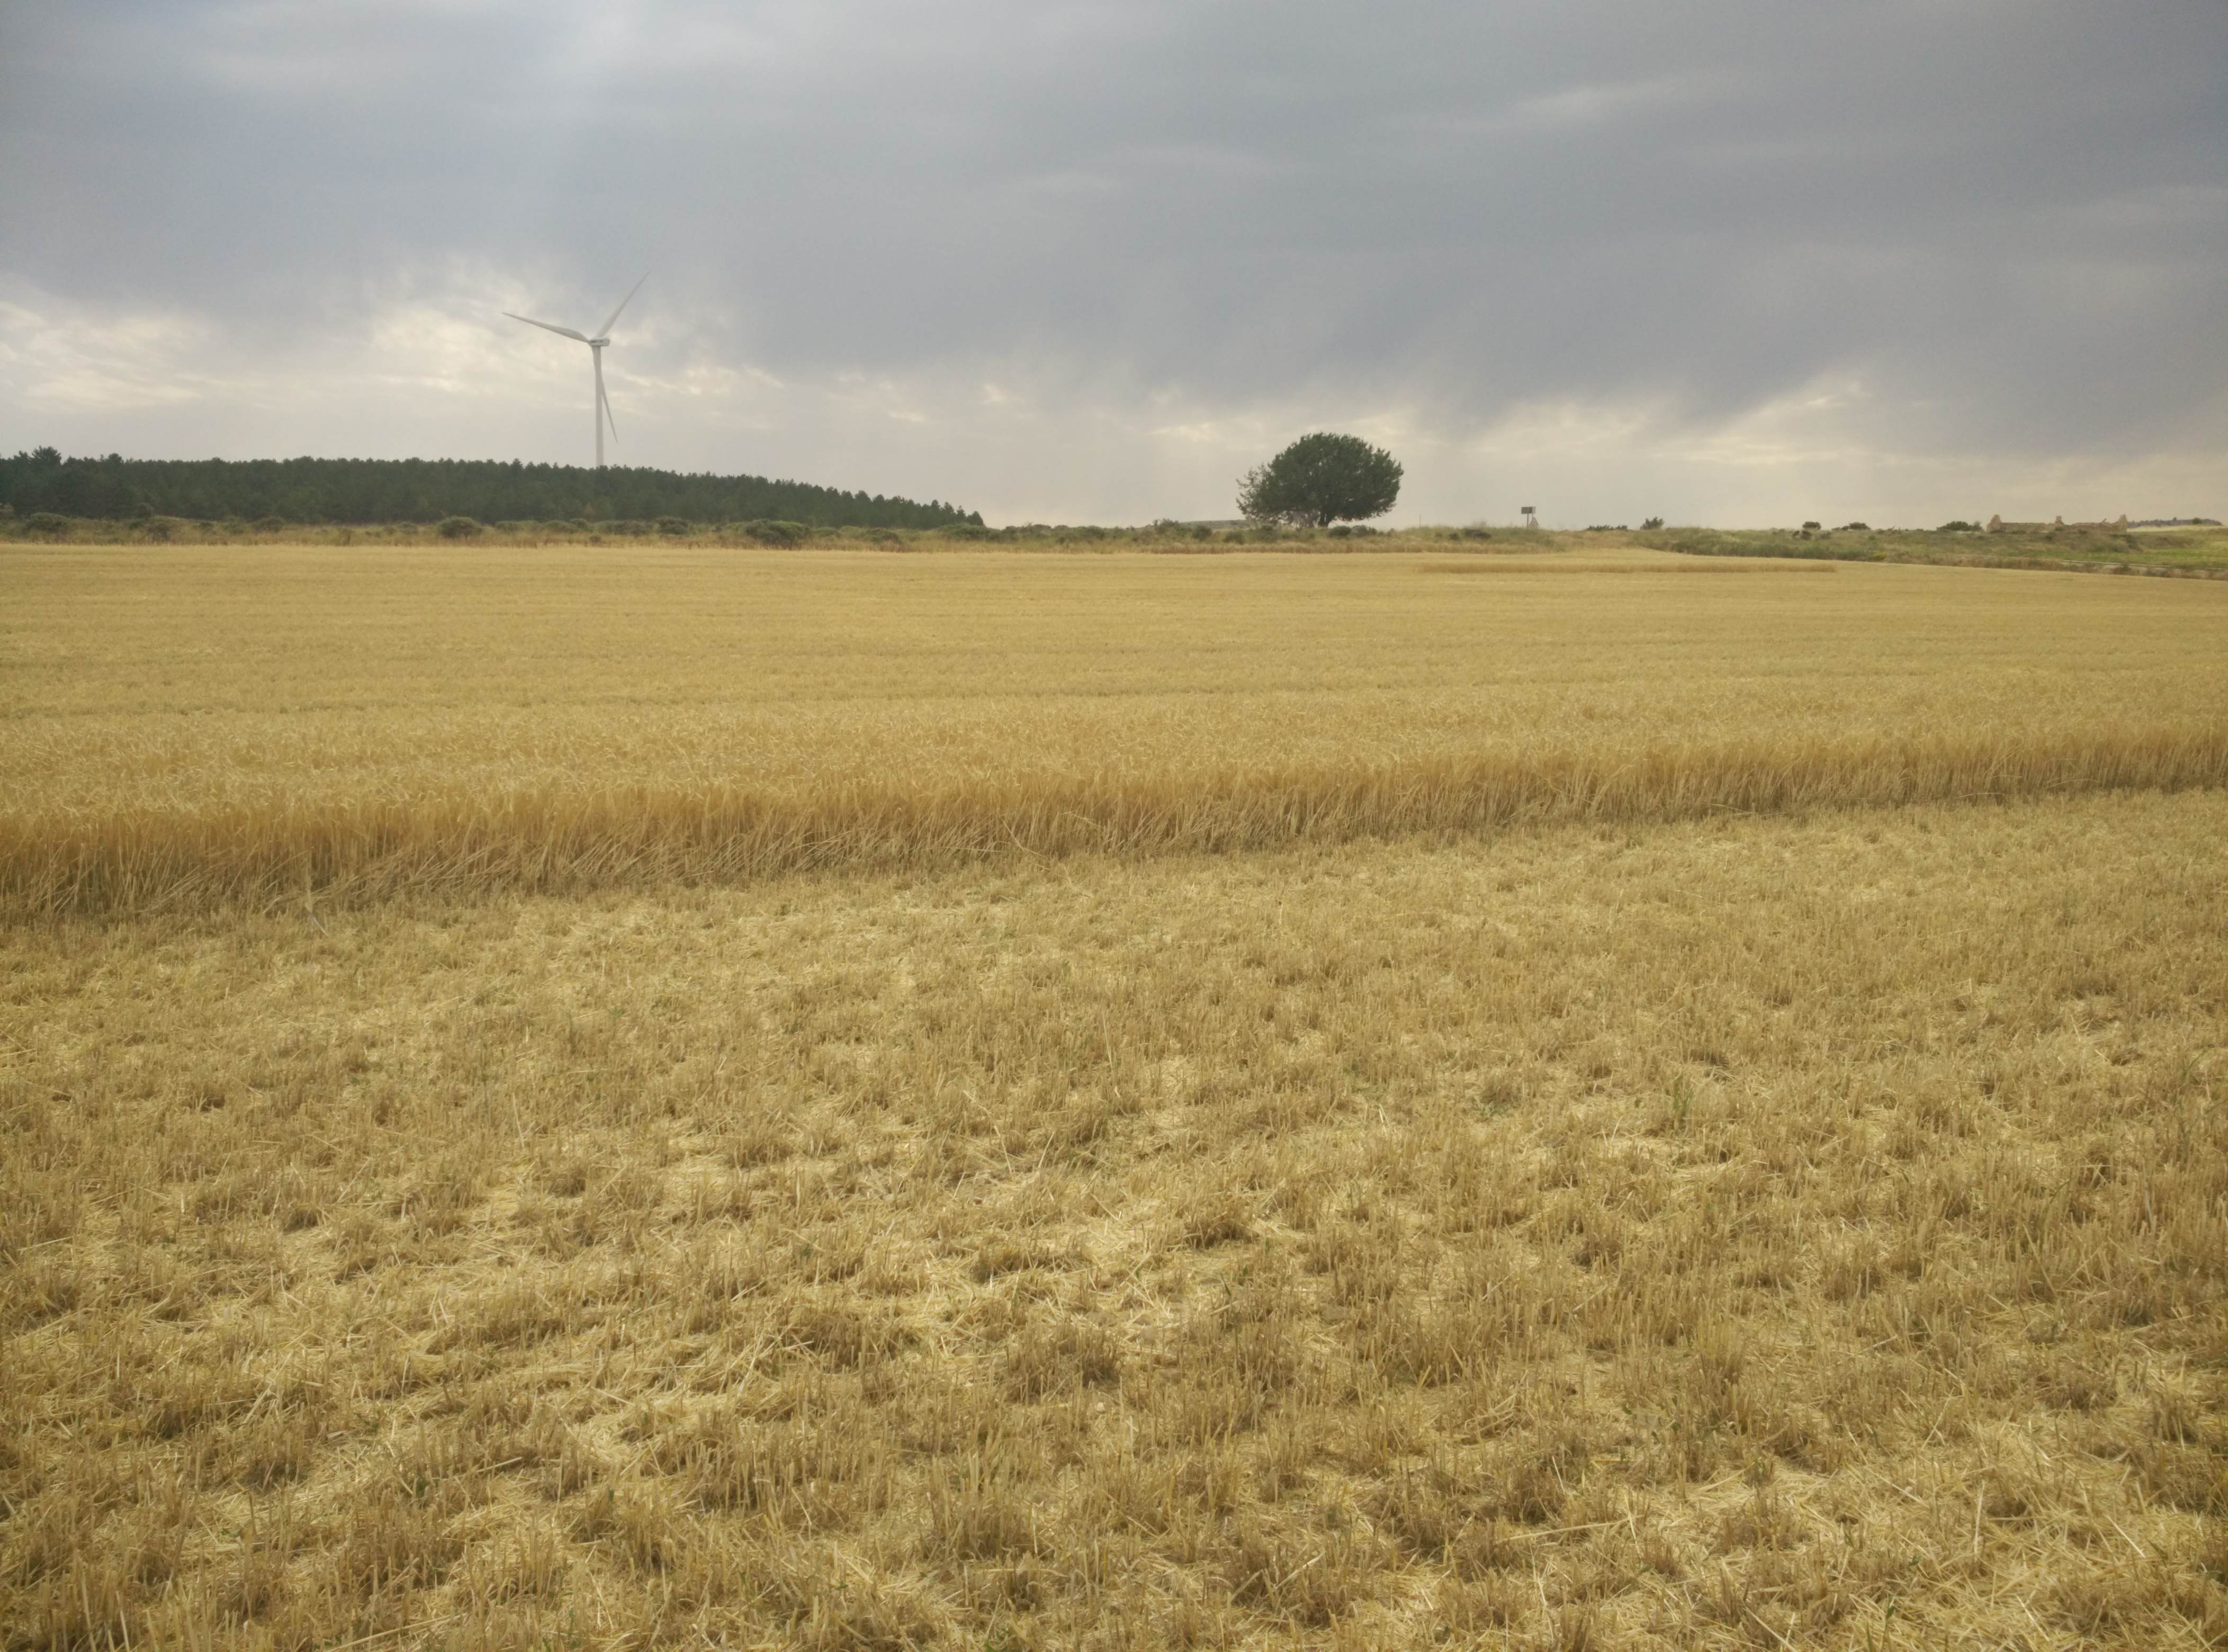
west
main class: Cropland
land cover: Barley
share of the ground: < 10 %
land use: Agriculture (excluding fallow land and kitchen gardens)
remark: Harvested field
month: July
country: ES
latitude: 41.0246
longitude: -1.8573
